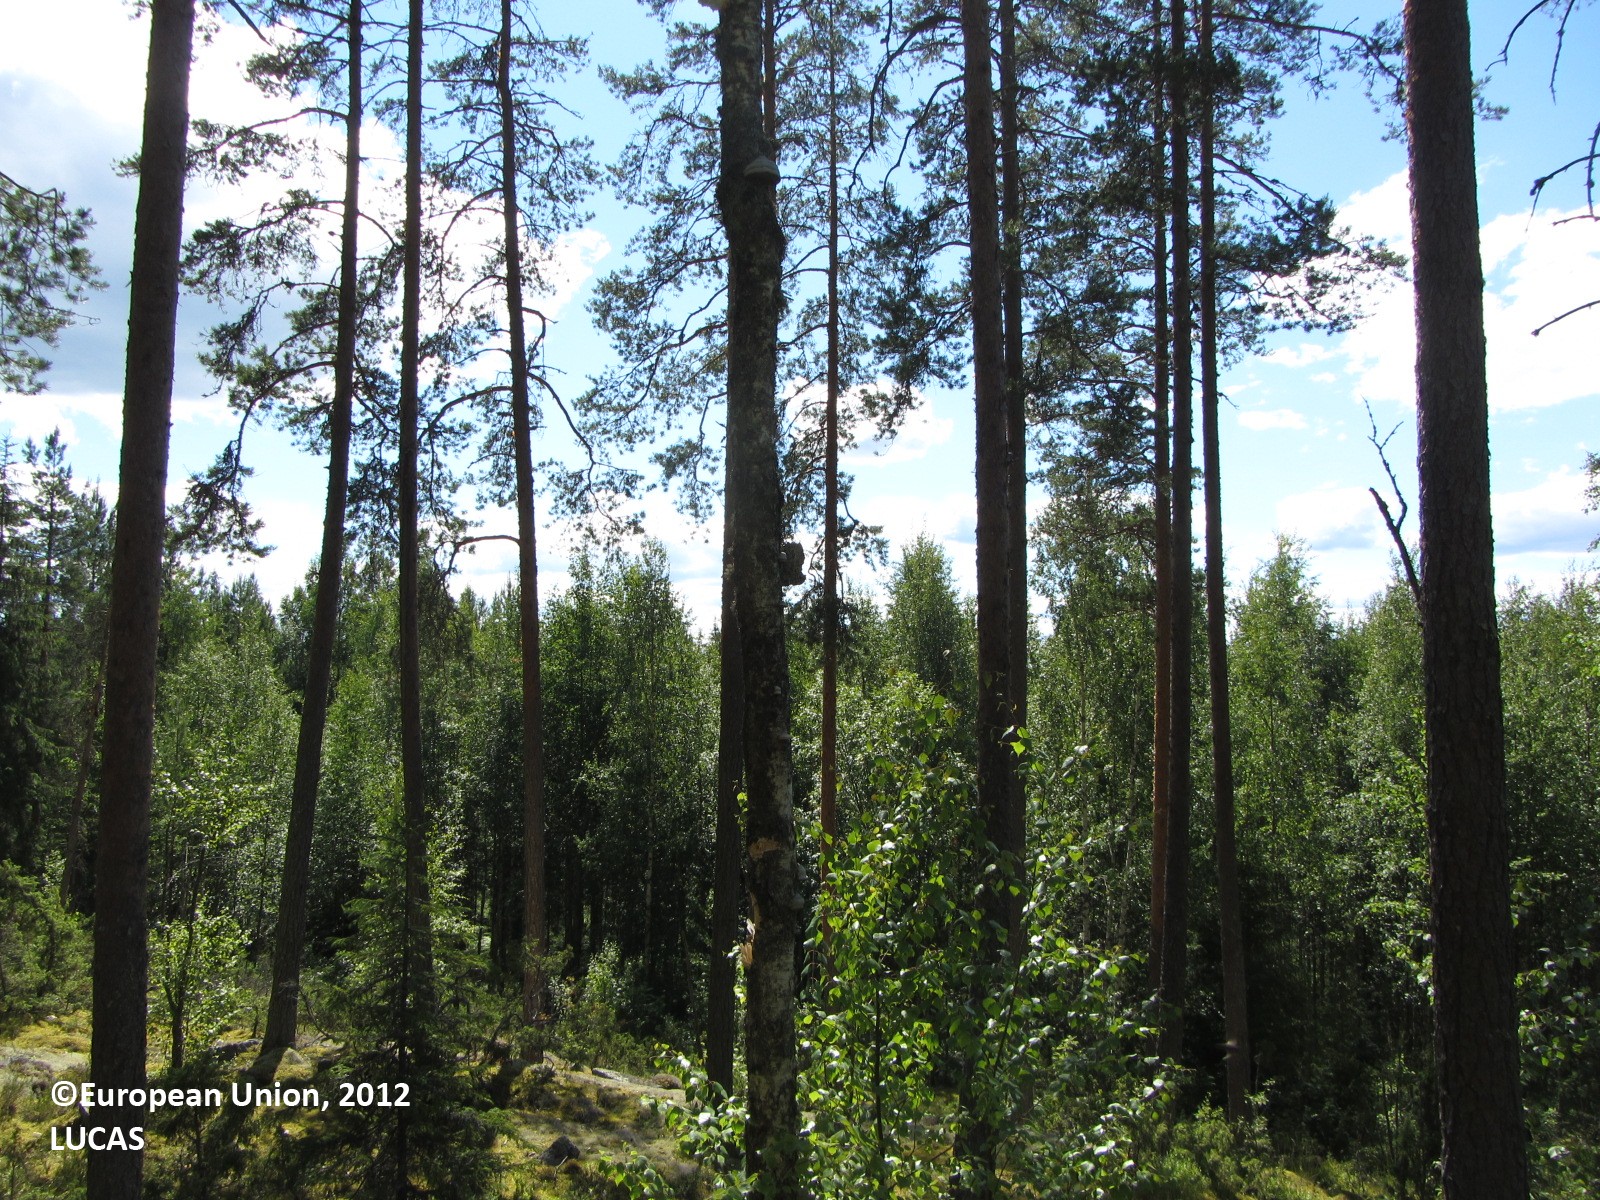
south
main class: Woodland
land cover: Pine dominated coniferous woodland
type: boreal forest
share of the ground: > 75 %
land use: Forestry
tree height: > 5 m
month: July
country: FI
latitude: 63.0650
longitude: 25.6022
